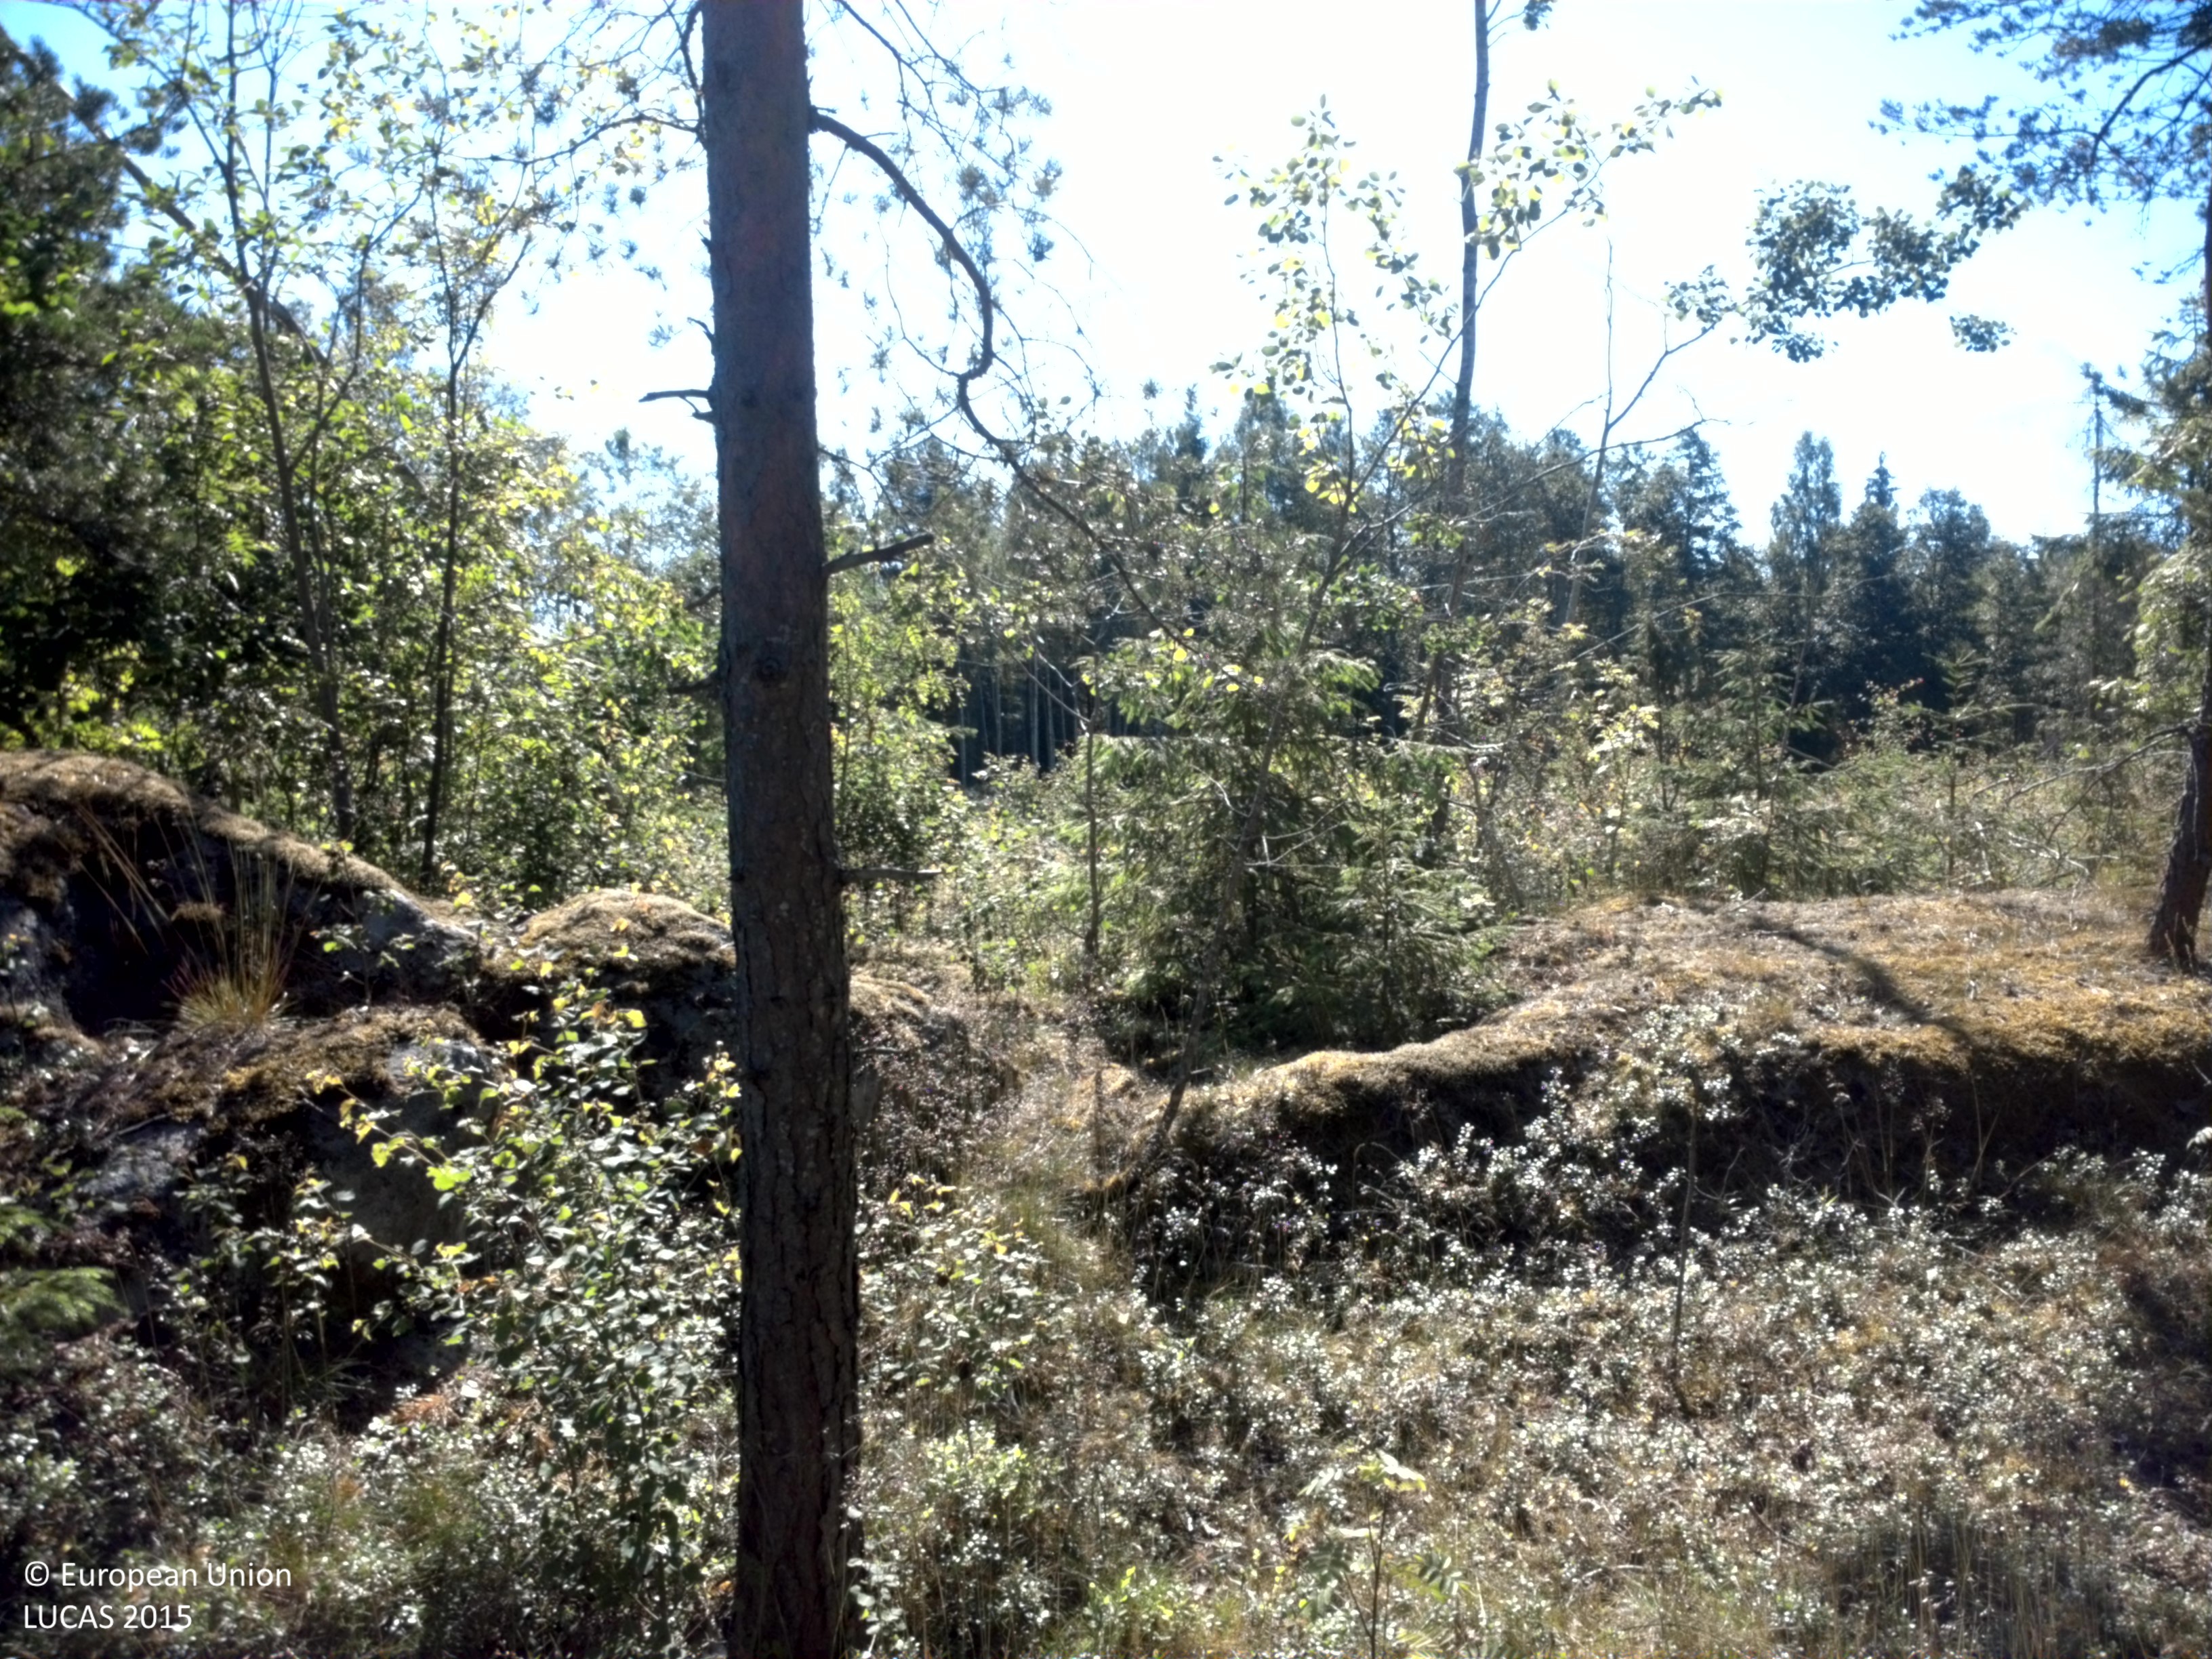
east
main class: Woodland
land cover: Pine dominated mixed woodland
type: boreal forest
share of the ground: 25 - 50 %
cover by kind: coniferous forest trees 35 %, lichens and mosses 25 %, shrubs 20 %, broadleaved forest trees 15 %, herbaceous plants 5 %
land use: Forestry
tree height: > 5 m
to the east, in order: Pine dominated mixed woodland; Shrubland with sparse tree cover; Grass margins; Paved roads, cycling and walking lanes; Grass margins; Spruce dominated mixed woodland; Electric lines; Shrubland with sparse tree cover; Broadleaved woodland; Inland marshes; Inland fresh water bodies
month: July
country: SE
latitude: 59.2812
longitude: 13.1344
